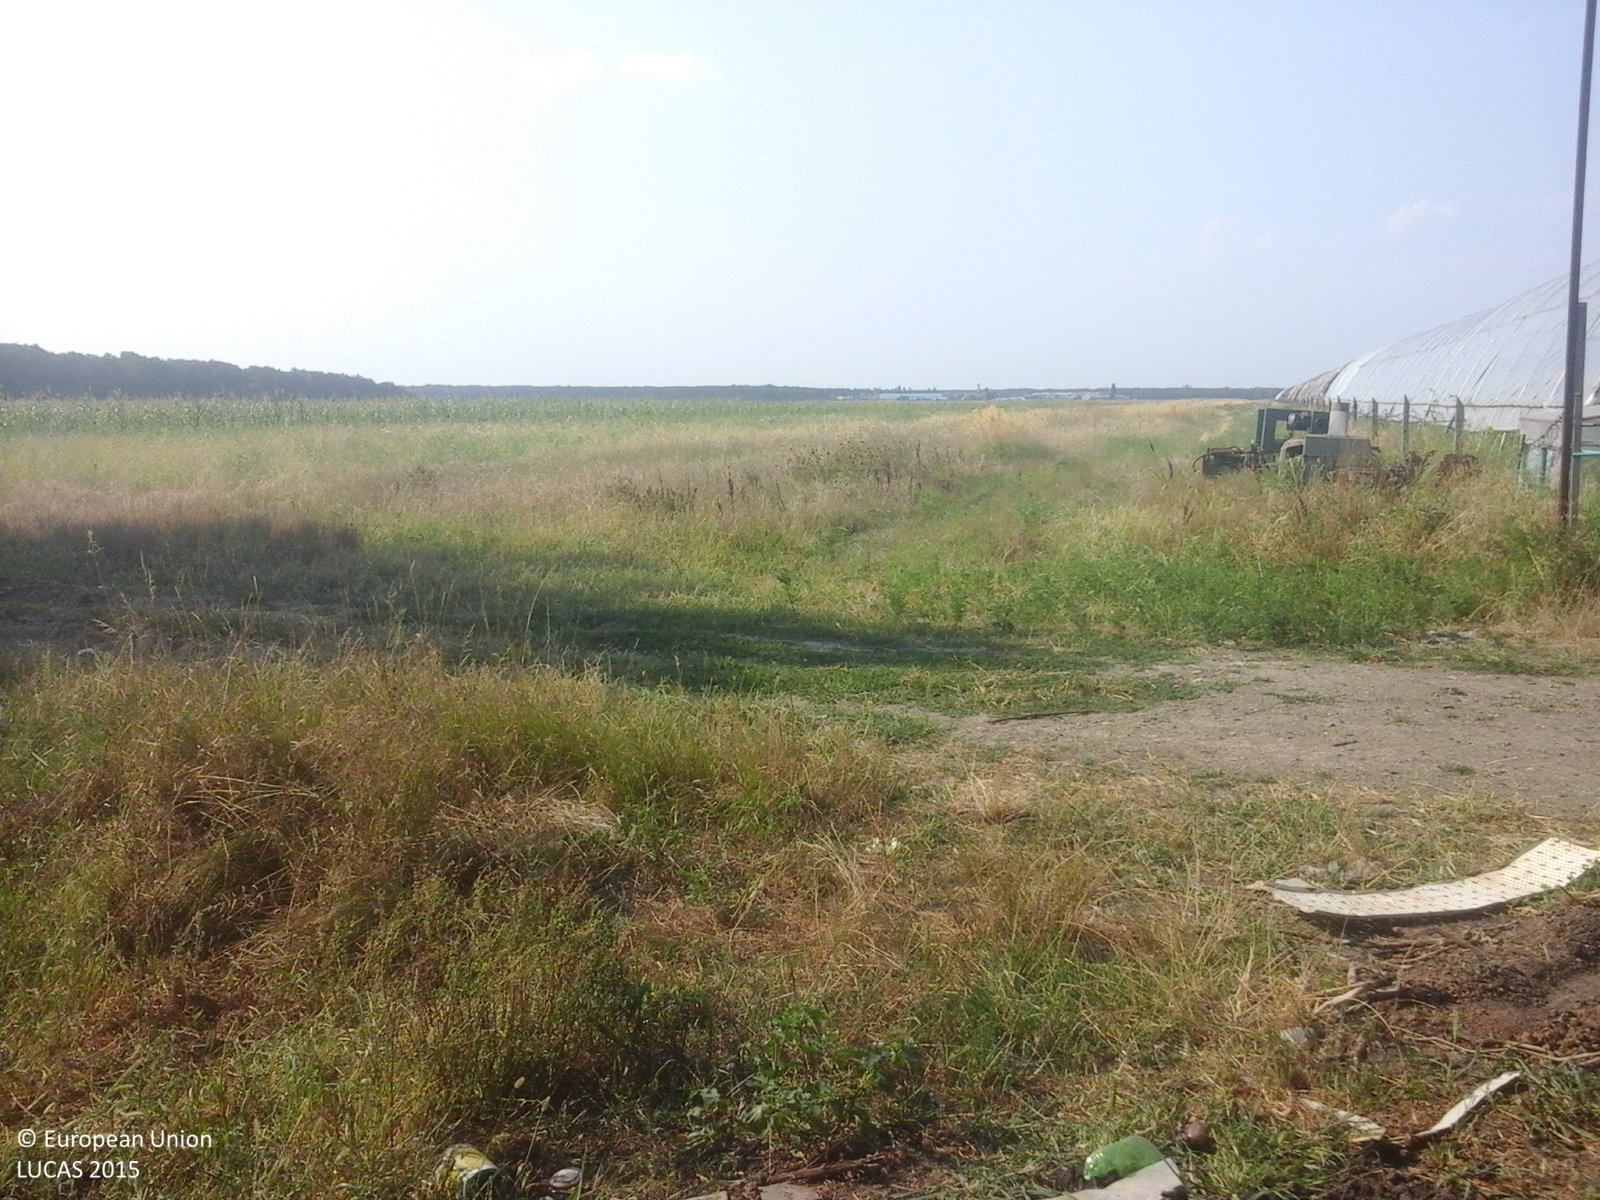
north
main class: Woodland
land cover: Broadleaved woodland
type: acidophilous oak and oak-birch forest
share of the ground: > 75 %
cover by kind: broadleaved forest trees 100 %
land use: Forestry
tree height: > 5 m
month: August
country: RO
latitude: 44.2743
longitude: 23.7240
